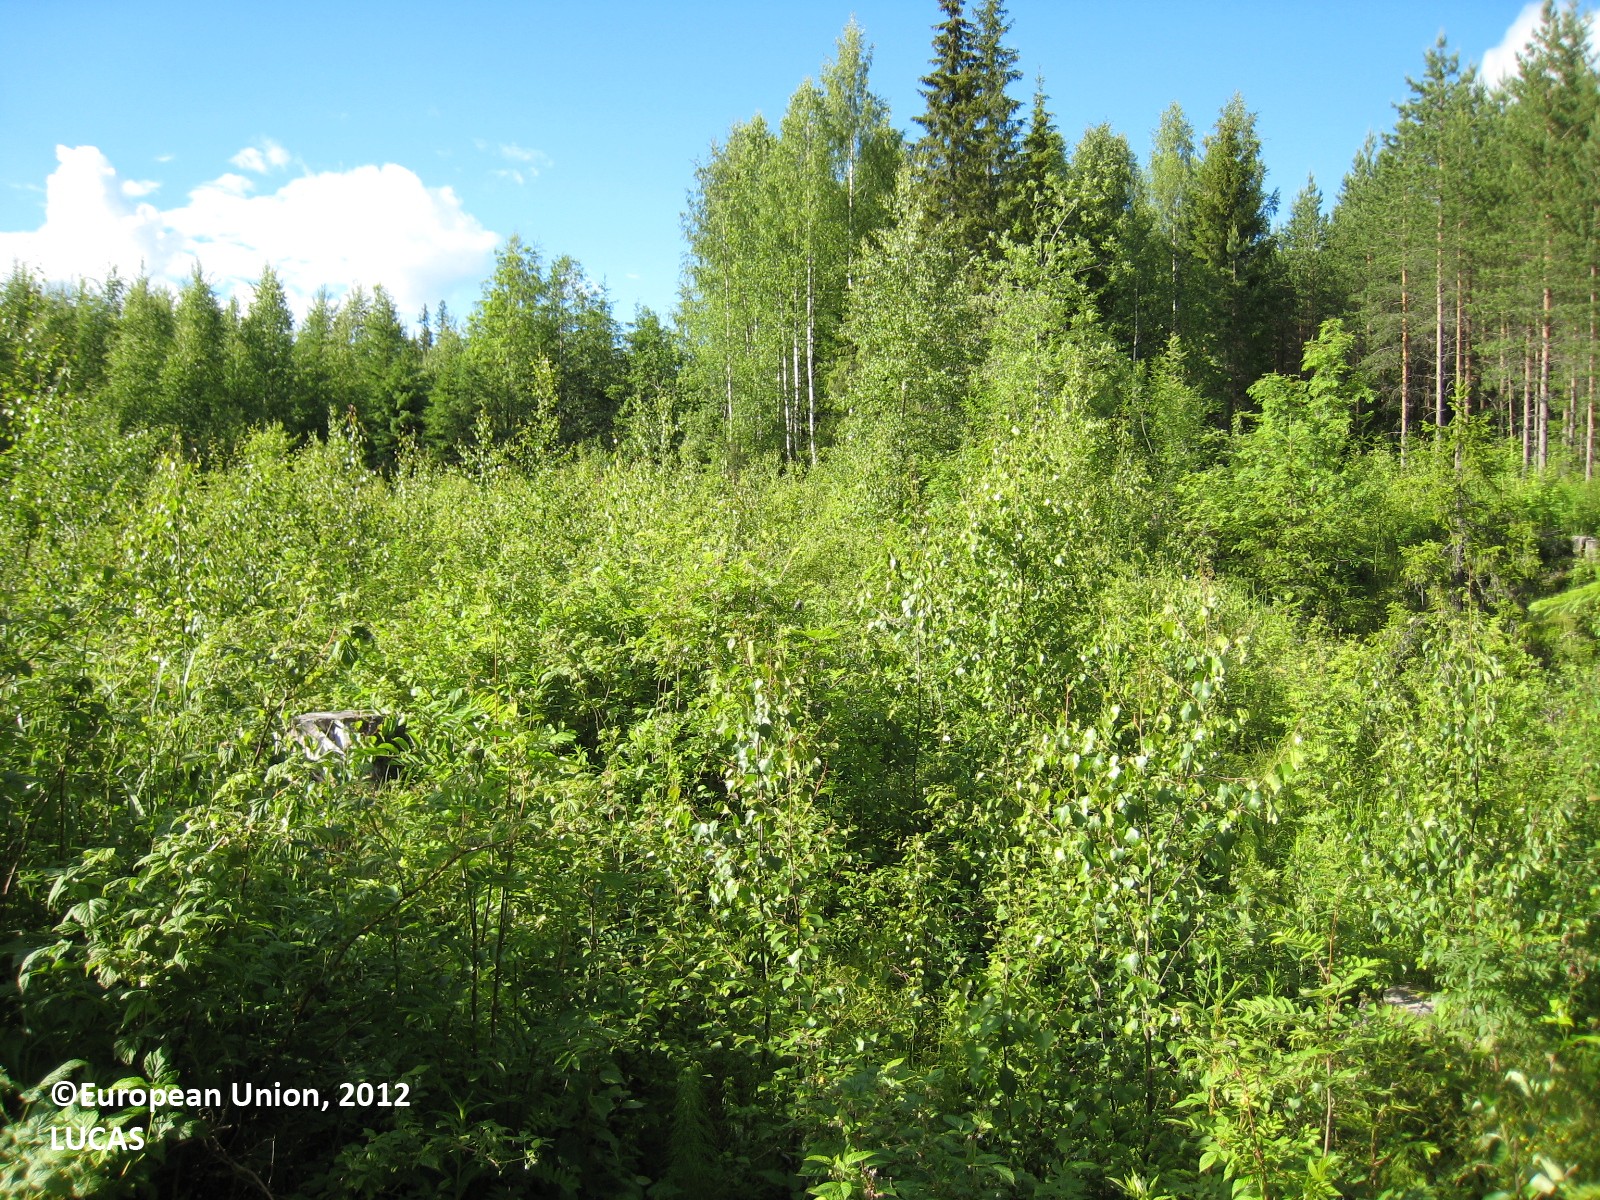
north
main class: Woodland
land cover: Broadleaved woodland
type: boreal forest
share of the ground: 25 - 50 %
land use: Forestry
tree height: < 5 m
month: June
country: FI
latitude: 62.4840
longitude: 26.5335
